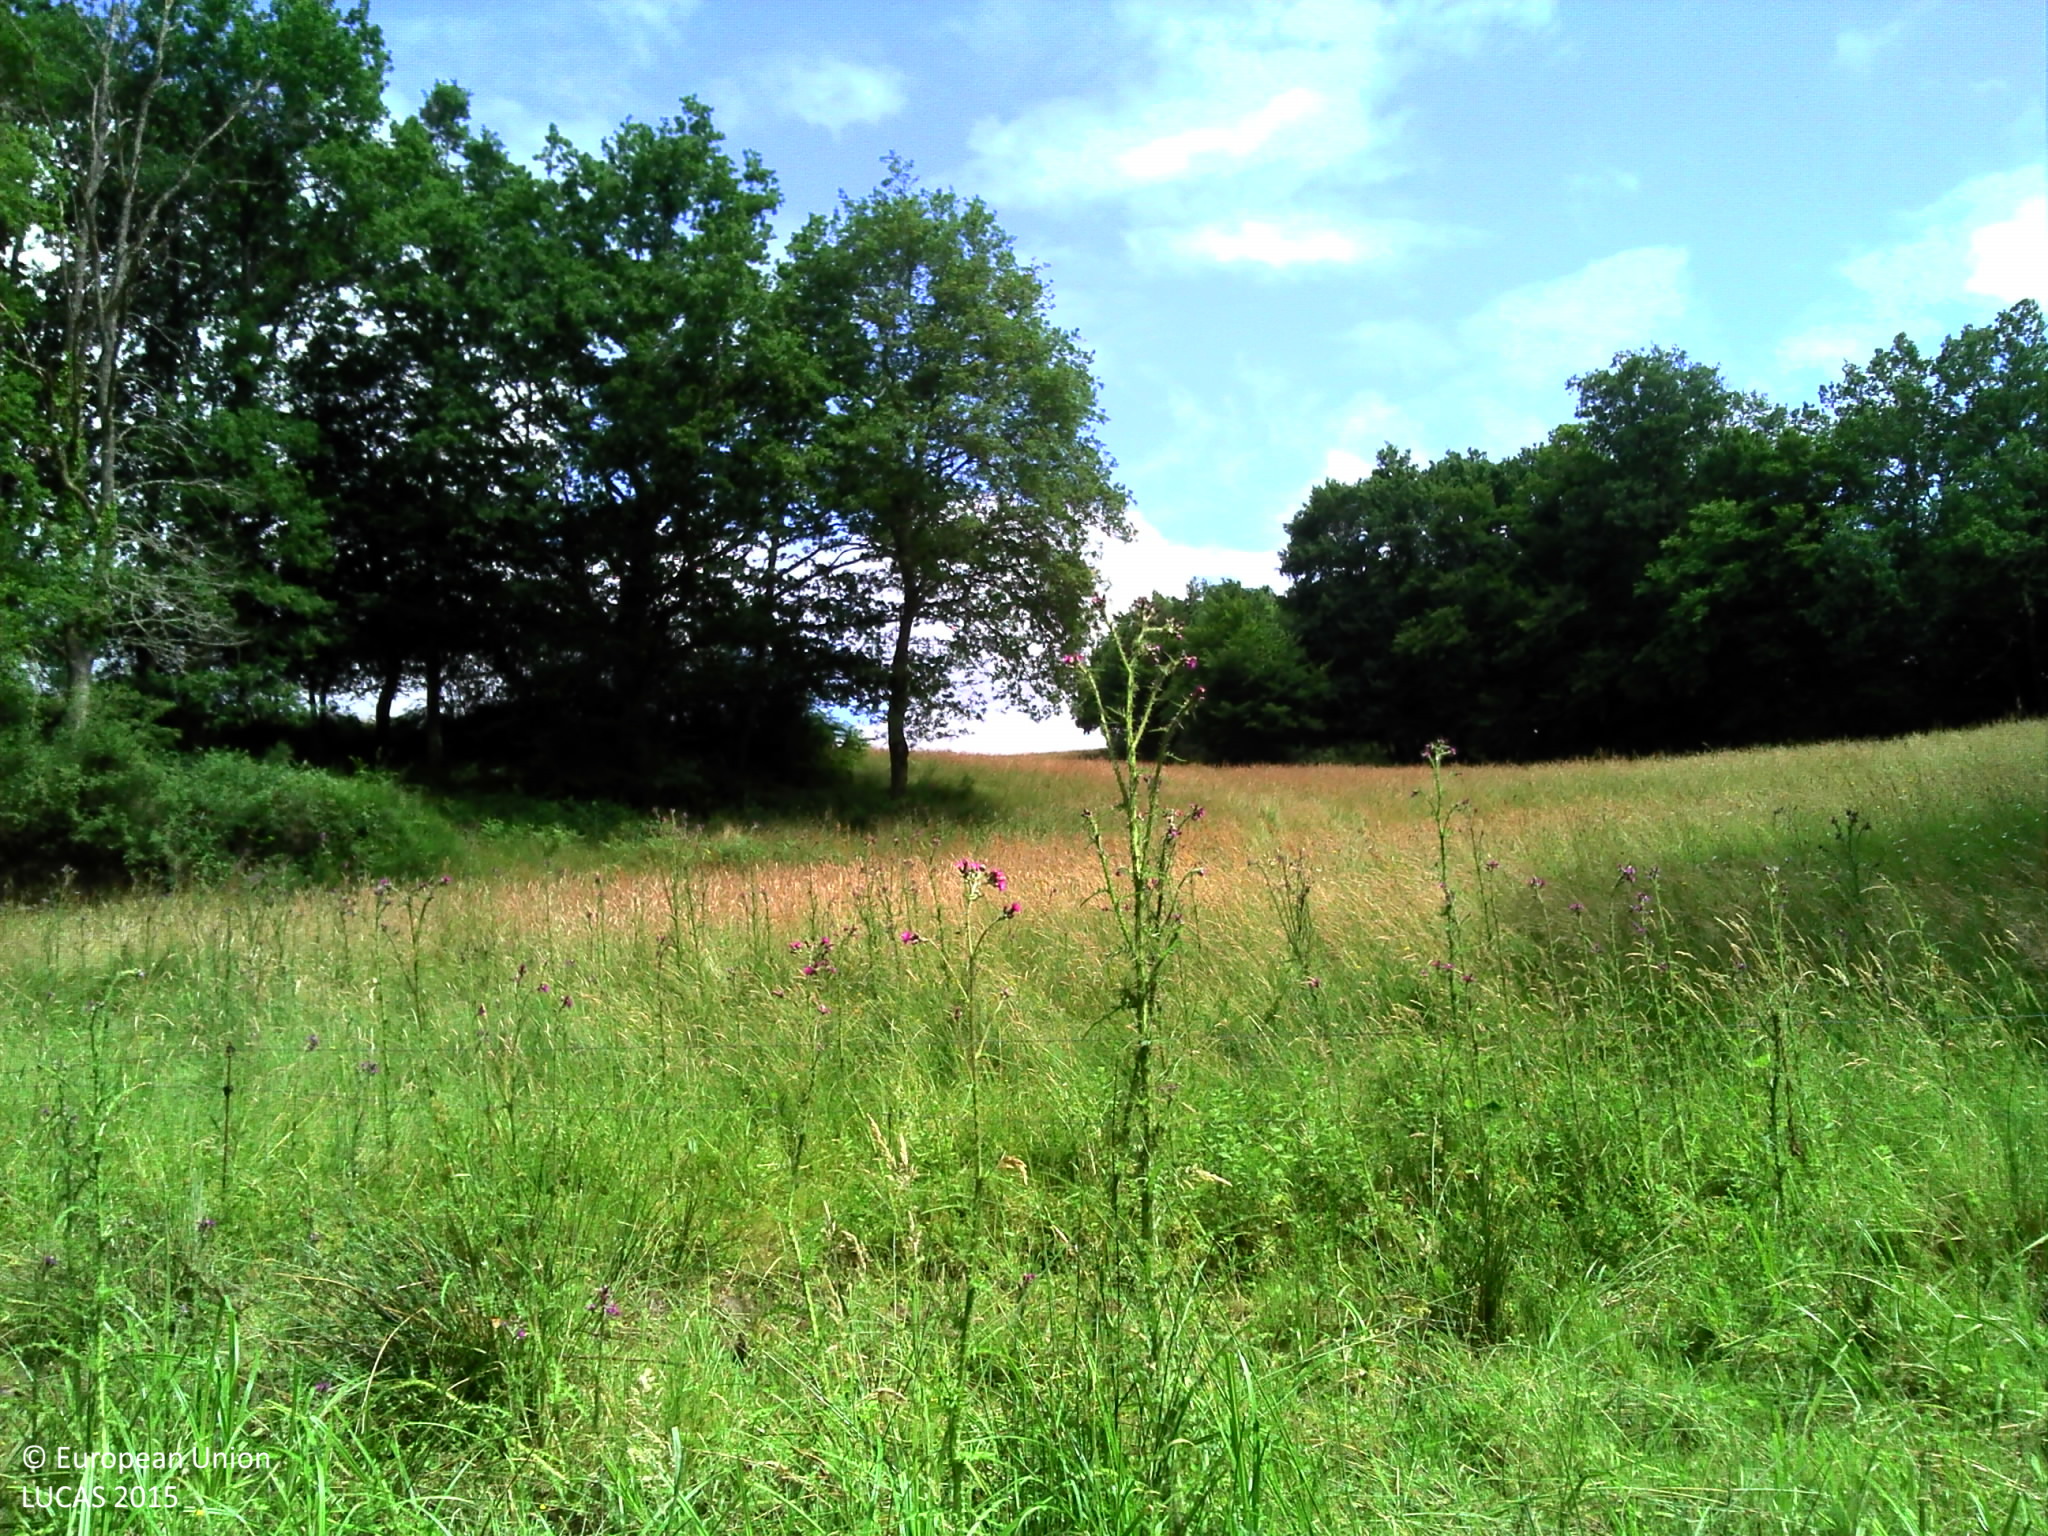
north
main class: Woodland
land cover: Broadleaved woodland
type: mesophytic deciduous forest
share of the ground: > 75 %
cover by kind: broadleaved forest trees 90 %, shrubs 10 %
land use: Forestry
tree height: > 5 m
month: June
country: FR
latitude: 46.2846
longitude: 3.0021
